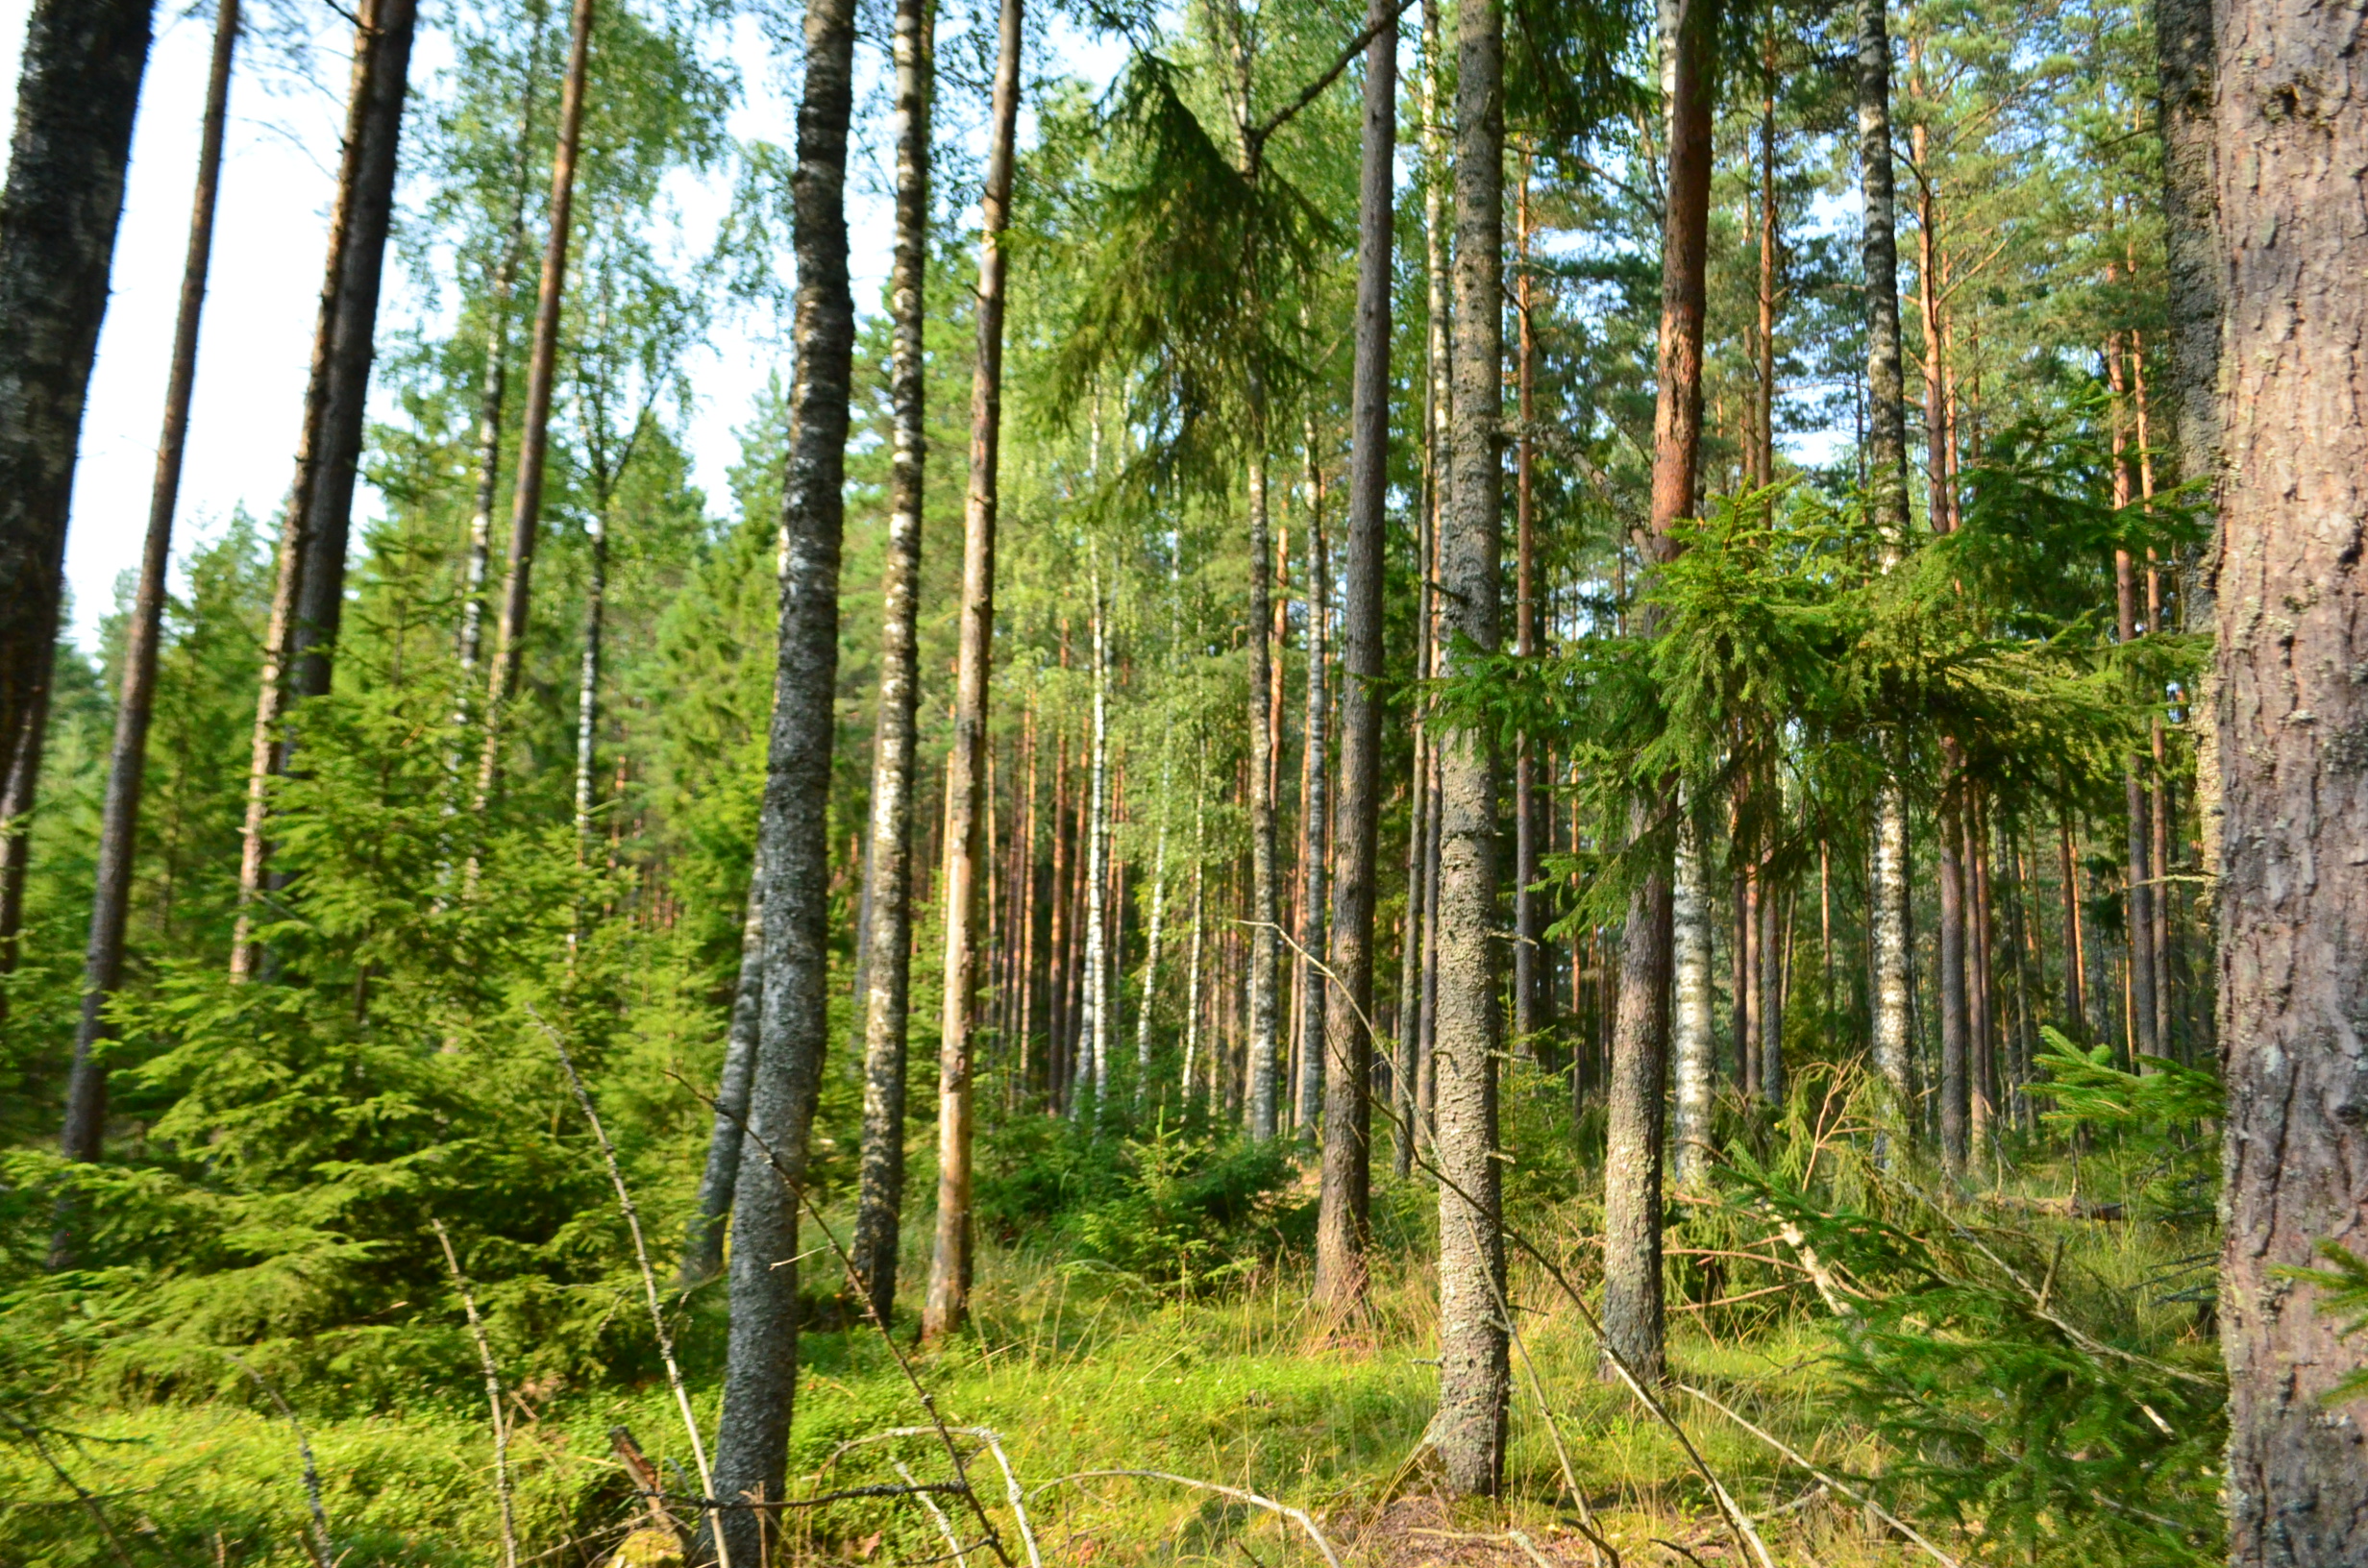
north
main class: Woodland
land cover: Other coniferous woodland
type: hemiboreal forest and nemoral coniferous forest and mixed broadleaved-coniferous forest
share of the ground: 50 - 75 %
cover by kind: coniferous forest trees 60 %, broadleaved forest trees 10 %, shrubs 10 %, herbaceous plants 10 %, lichens and mosses 10 %
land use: Forestry
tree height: > 5 m
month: August
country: LV
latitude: 57.2903
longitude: 21.8744
